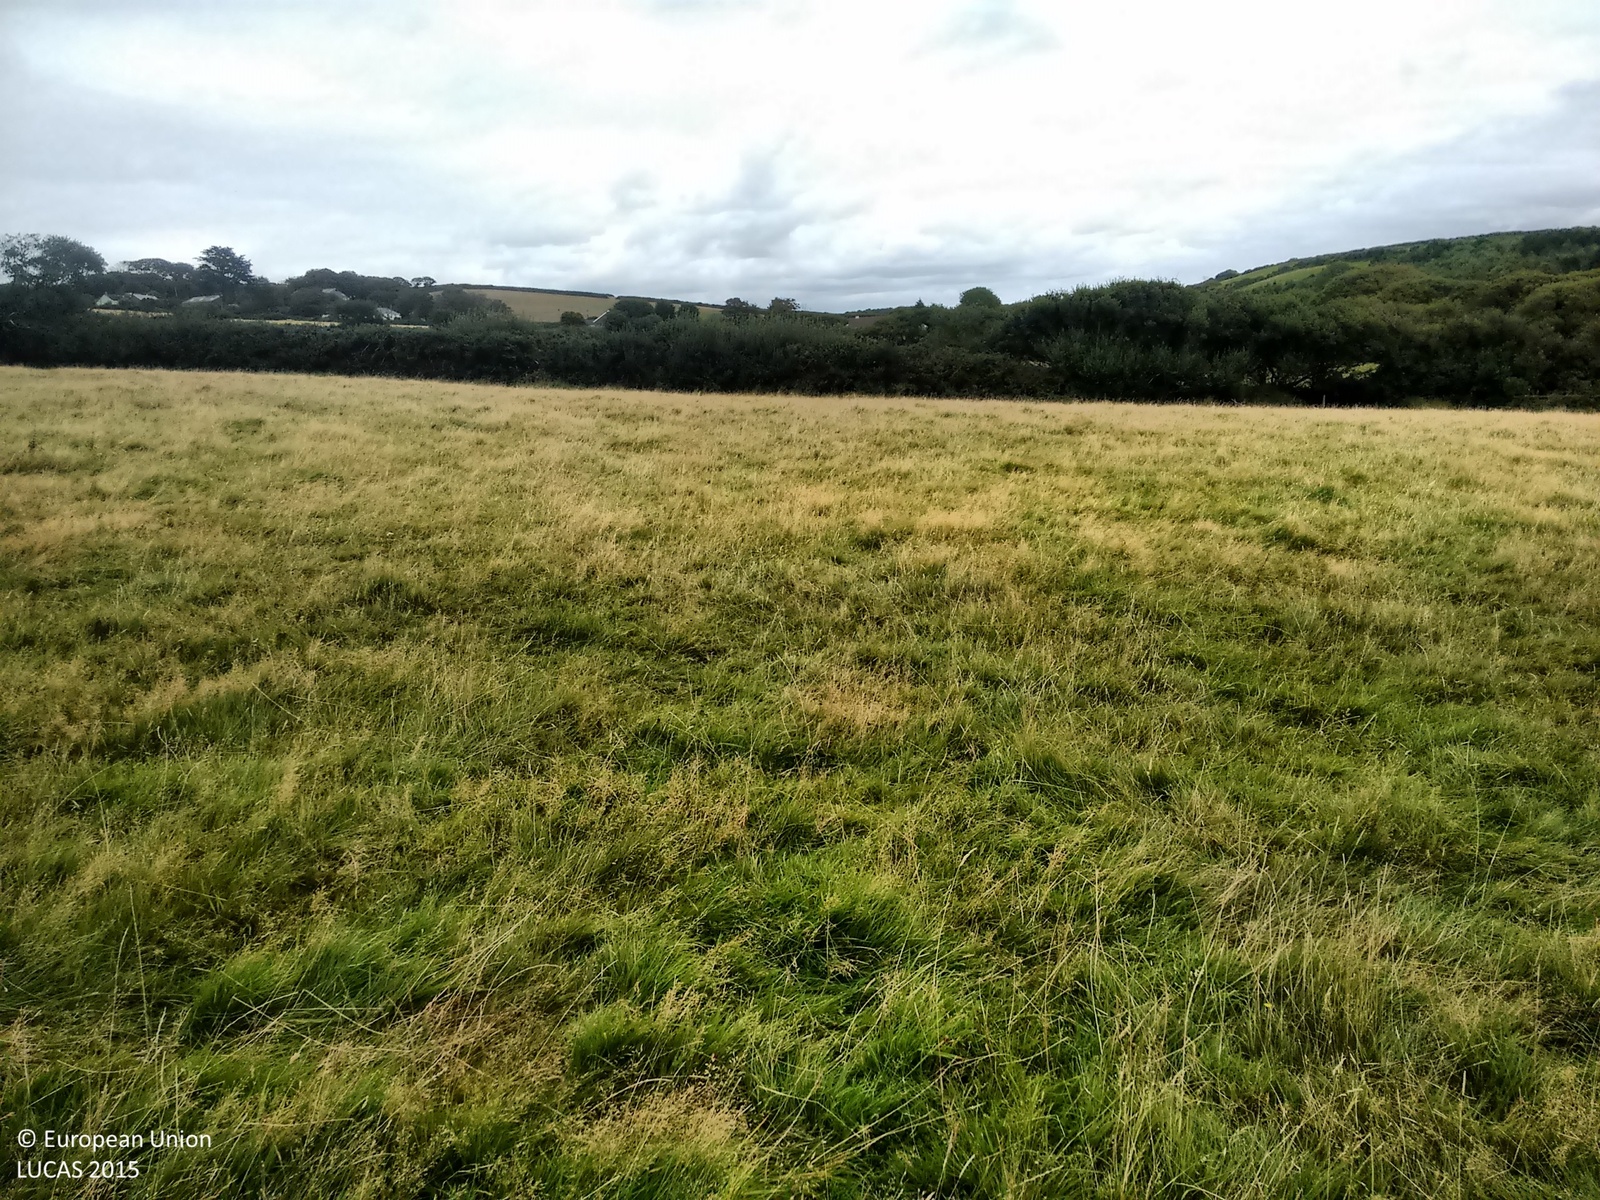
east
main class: Grassland
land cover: Grassland without tree/shrub cover
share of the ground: > 75 %
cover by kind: herbaceous plants 100 %
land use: Agriculture (excluding fallow land and kitchen gardens)
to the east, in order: Grassland without tree/shrub cover; Managed hedges; Artificial constructions; Grassland without tree/shrub cover; Abandoned hedges; Grassland without tree/shrub cover
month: September
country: GB
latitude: 50.4541
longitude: -4.9457
